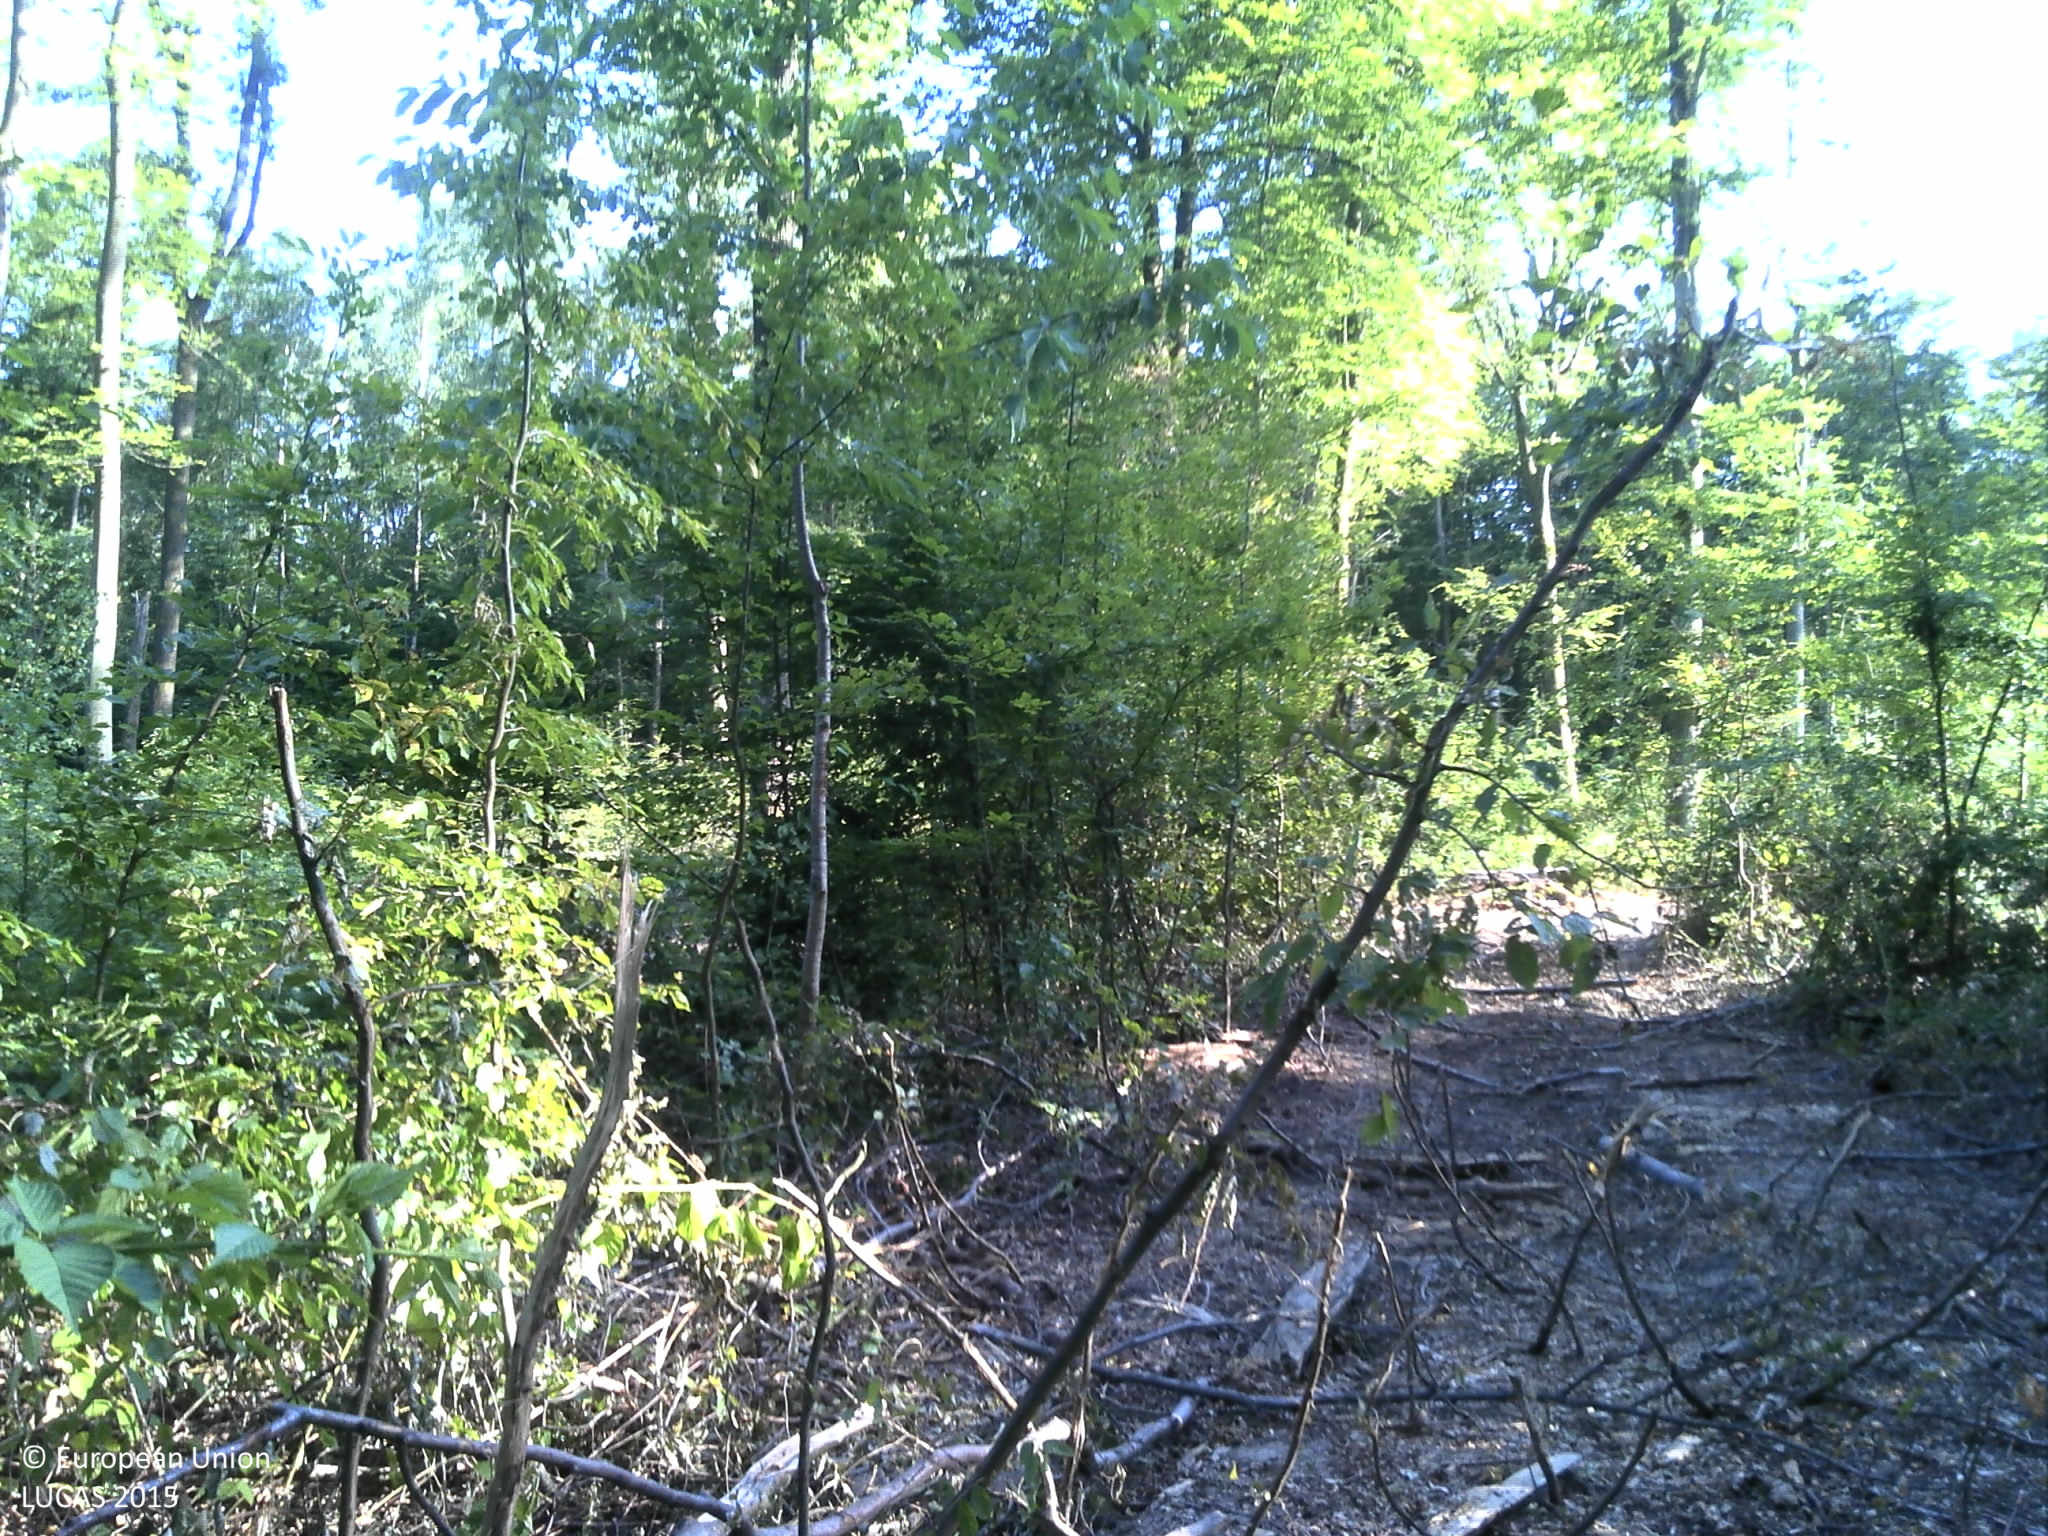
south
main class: Woodland
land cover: Broadleaved woodland
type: mesophytic deciduous forest
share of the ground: > 75 %
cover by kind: broadleaved forest trees 95 %, herbaceous plants 5 %
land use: Forestry
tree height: > 5 m
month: July
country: FR
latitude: 49.0957
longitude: 6.8093
